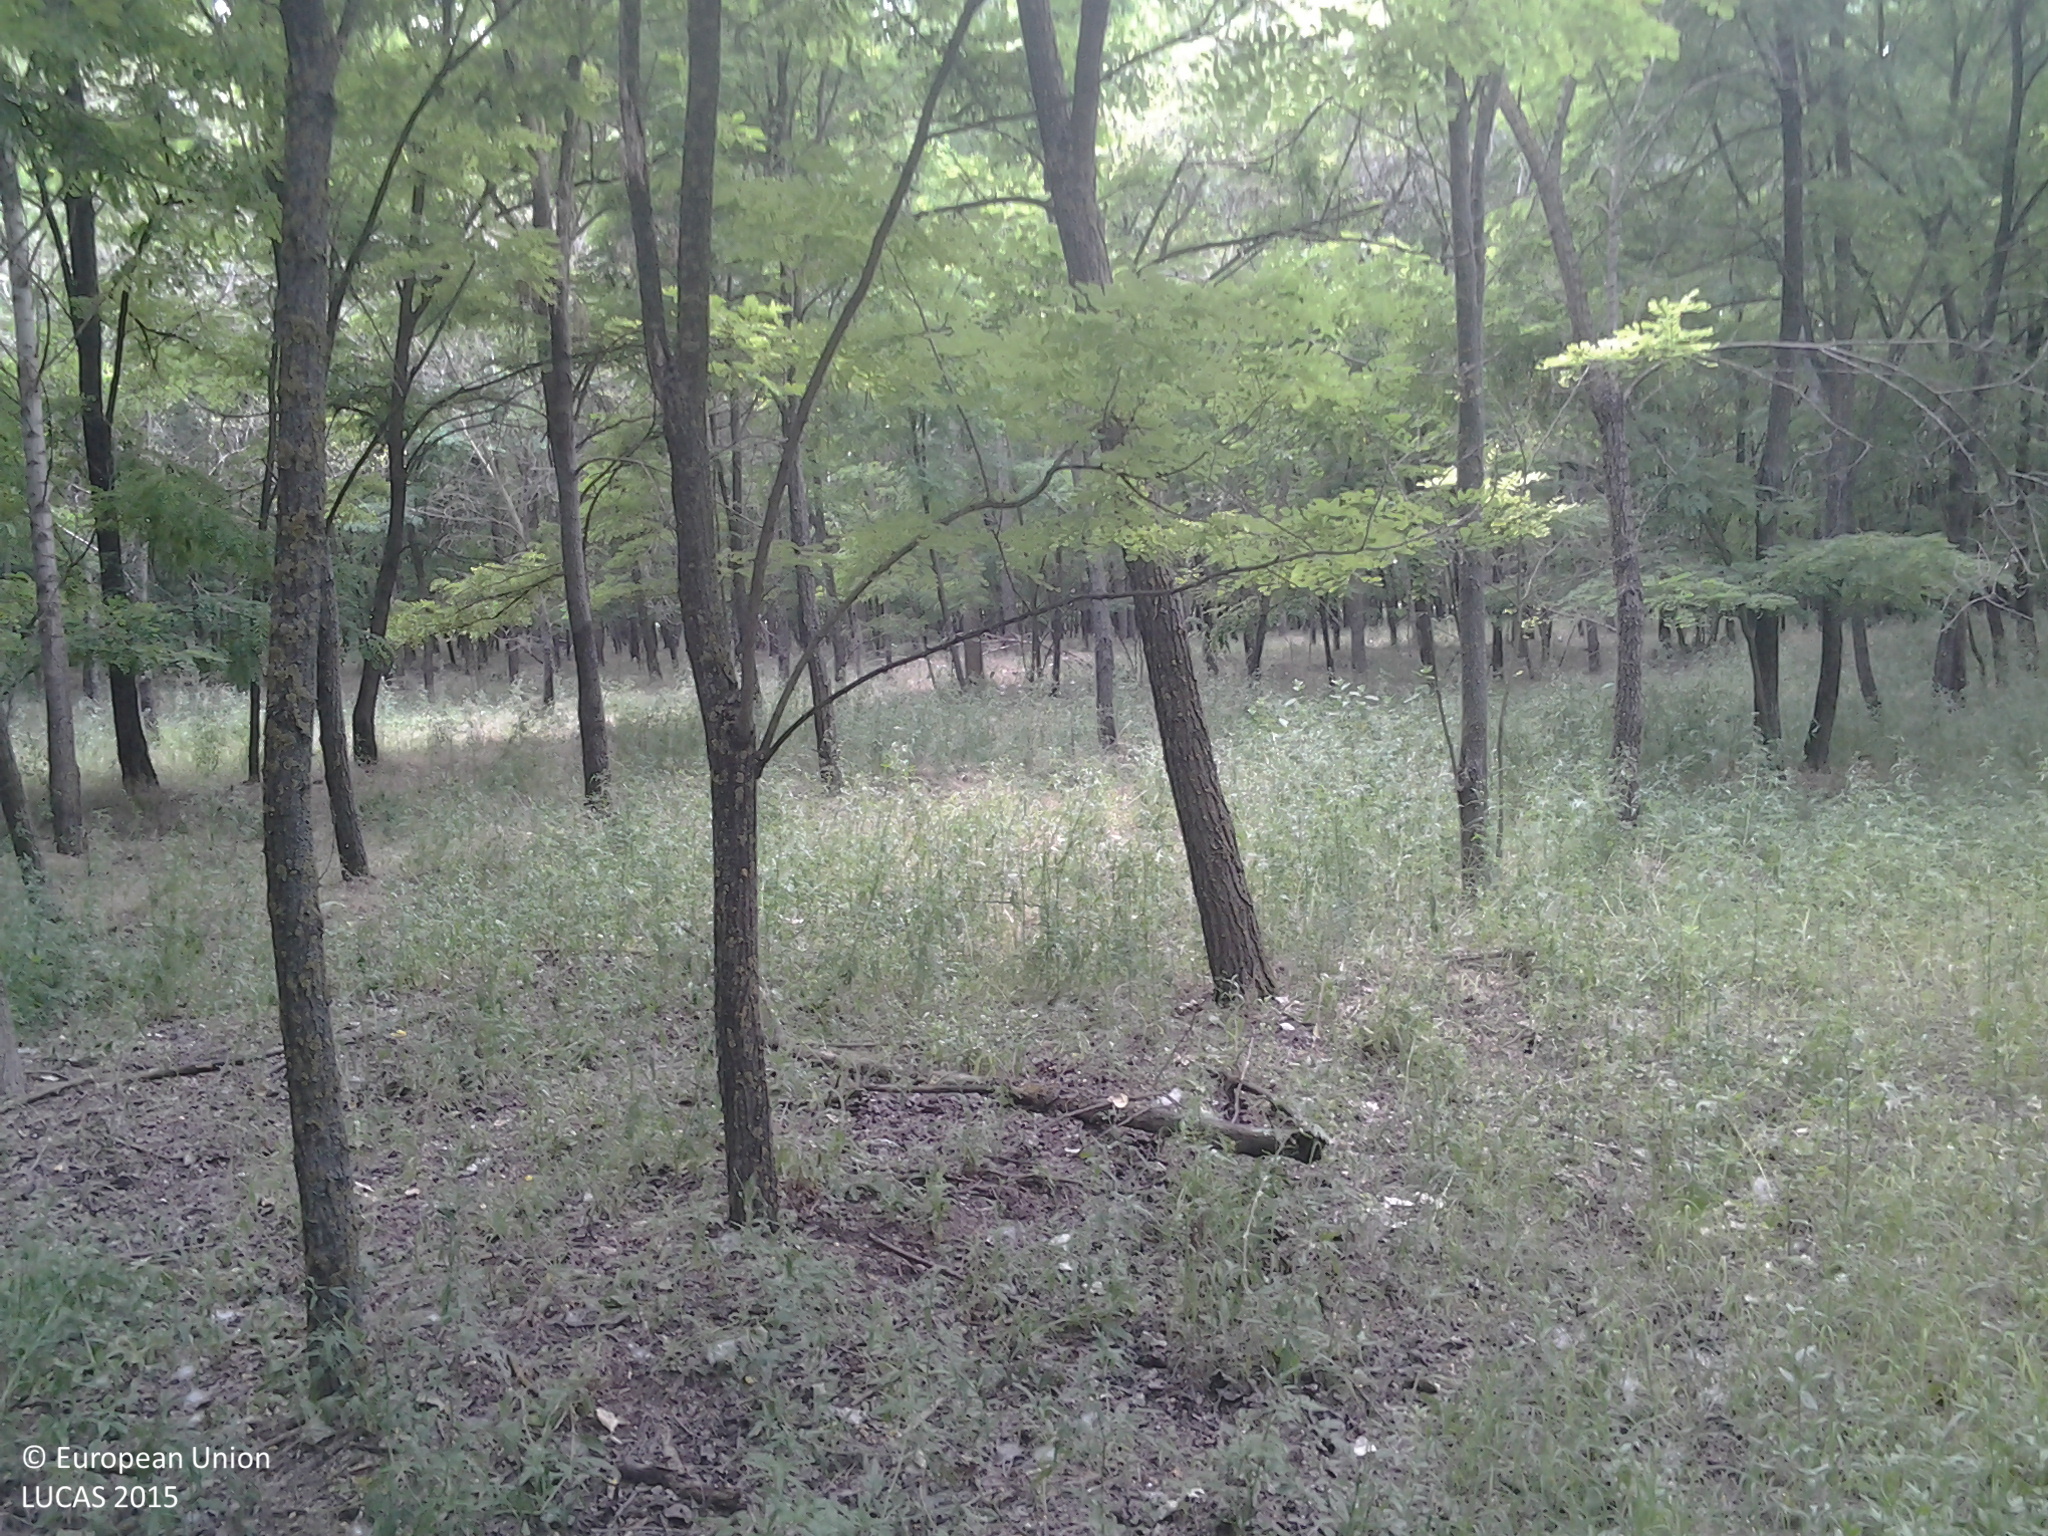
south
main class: Woodland
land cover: Broadleaved woodland
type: mesophytic deciduous forest
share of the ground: 25 - 50 %
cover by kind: broadleaved forest trees 100 %
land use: Forestry
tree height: > 5 m
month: June
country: HU
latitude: 46.7929
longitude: 19.7546
